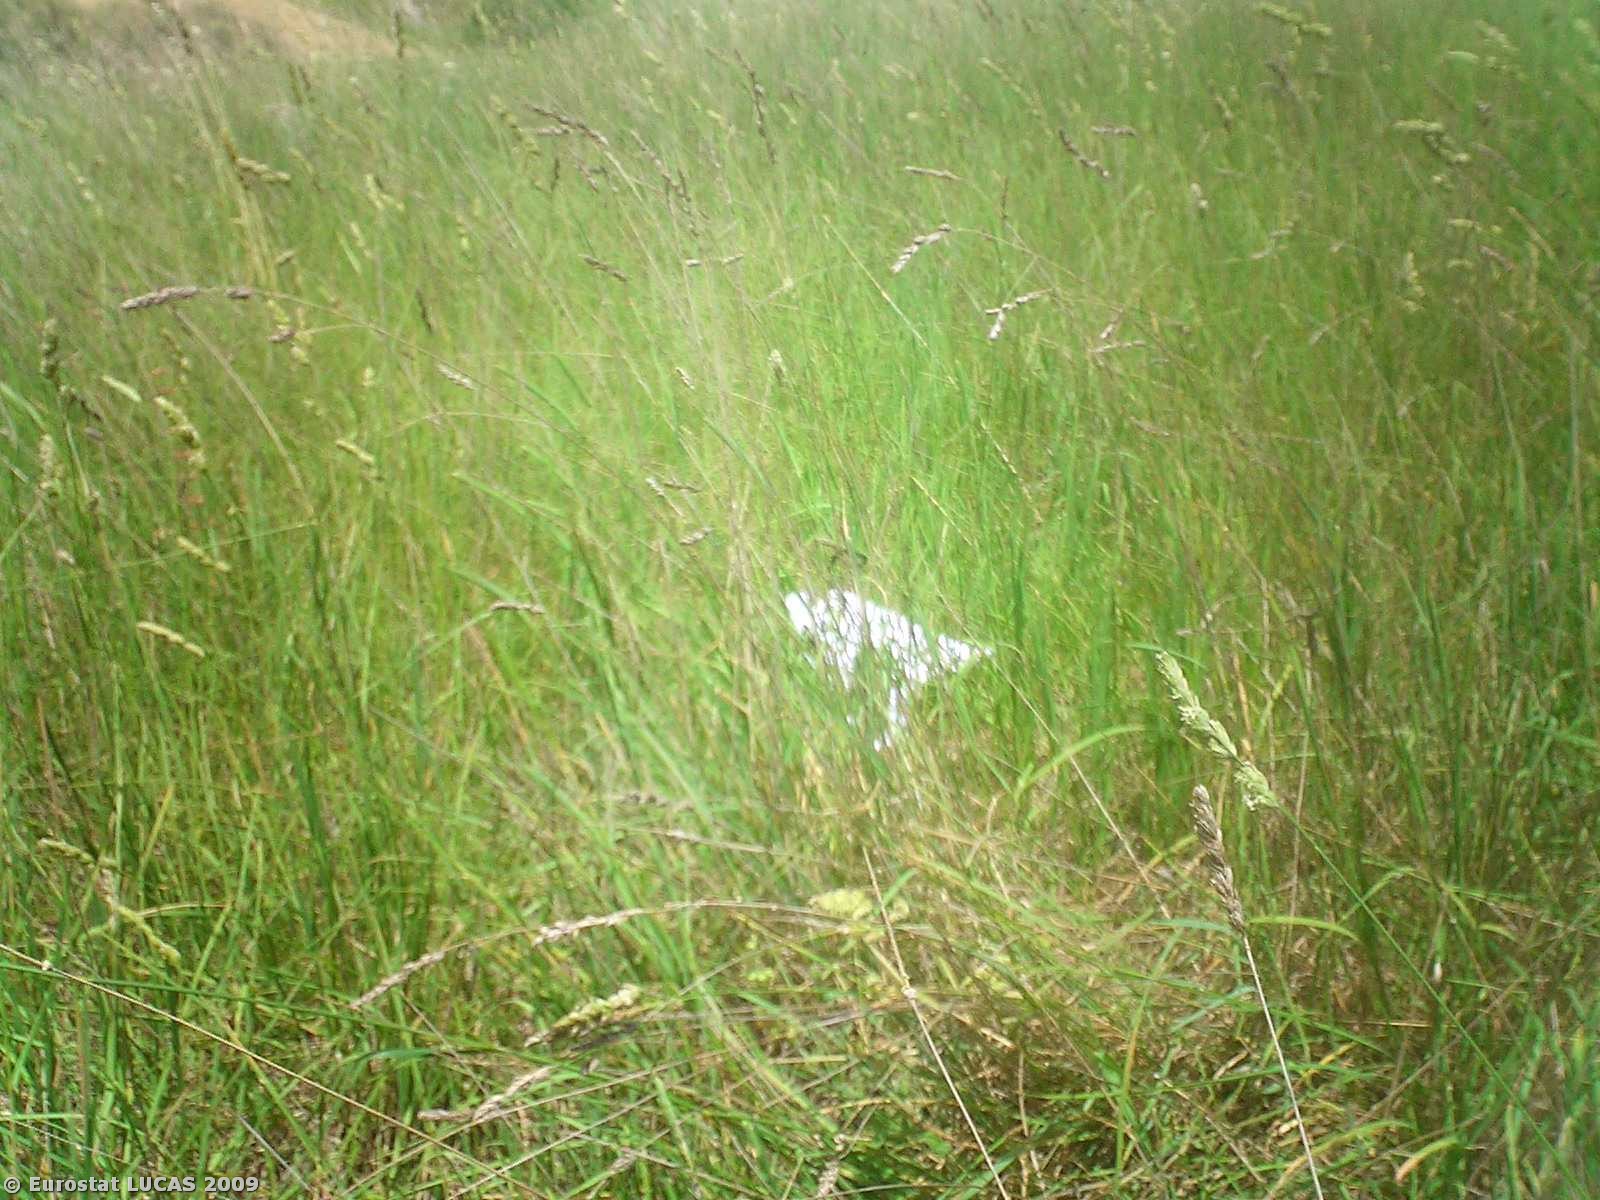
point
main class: Grassland
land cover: Grassland without tree/shrub cover
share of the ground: > 75 %
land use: Agriculture (excluding fallow land and kitchen gardens)
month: May
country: IT
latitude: 44.2462
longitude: 11.7117
